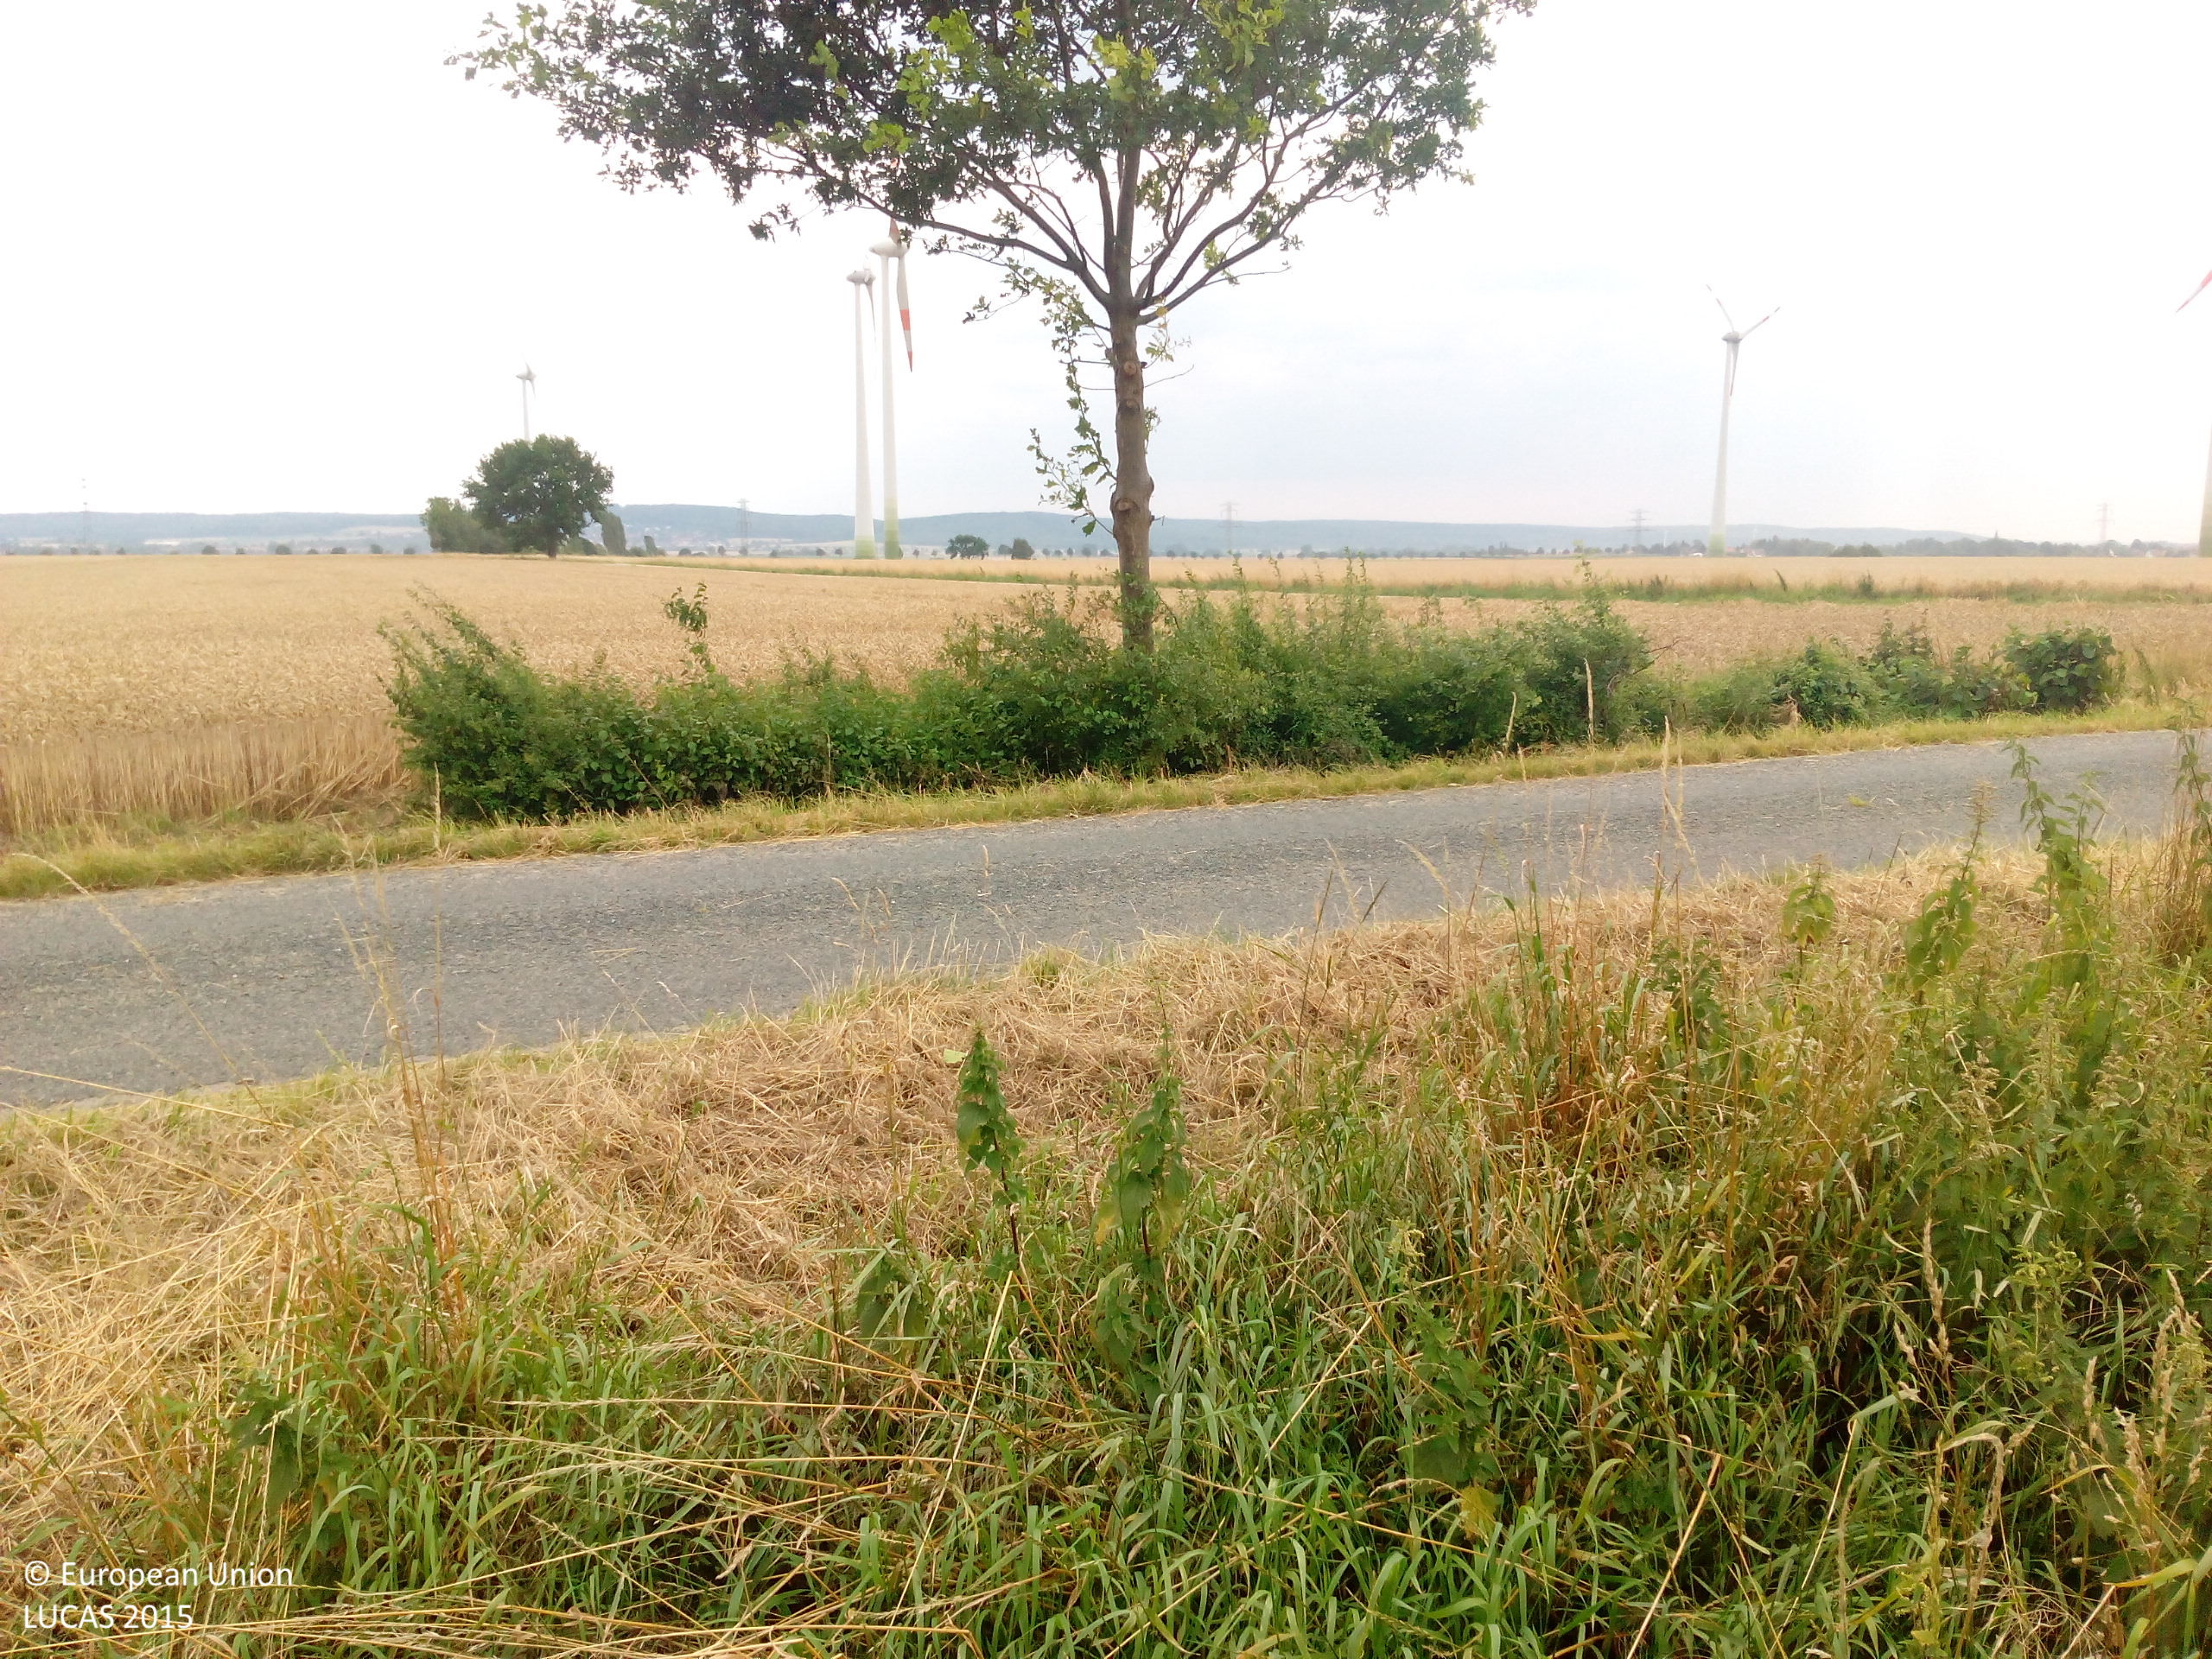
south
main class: Cropland
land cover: Sugar beet
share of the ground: > 75 %
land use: Agriculture (excluding fallow land and kitchen gardens)
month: August
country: DE
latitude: 52.1794
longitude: 10.2778
